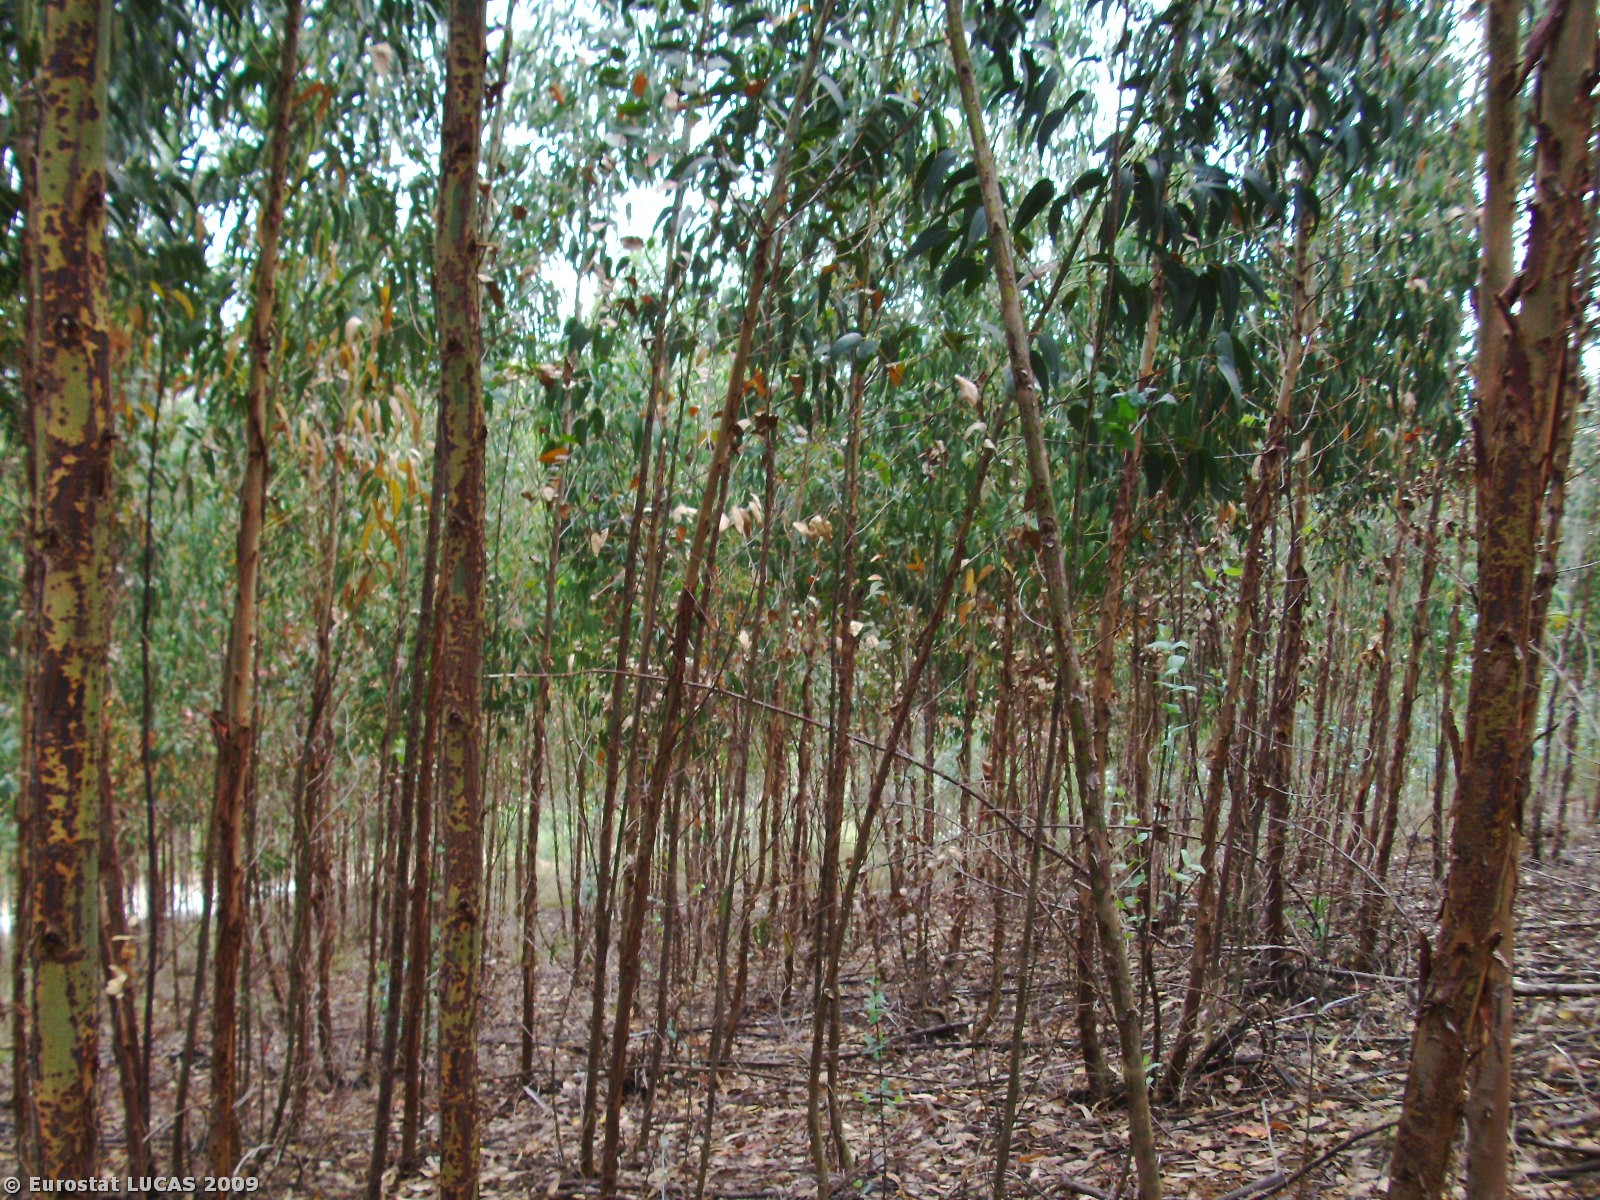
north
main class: Woodland
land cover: Broadleaved woodland
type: plantations and self-sown exotic forest
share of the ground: > 75 %
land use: Forestry
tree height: > 5 m
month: June
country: PT
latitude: 39.8351
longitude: -8.3384
